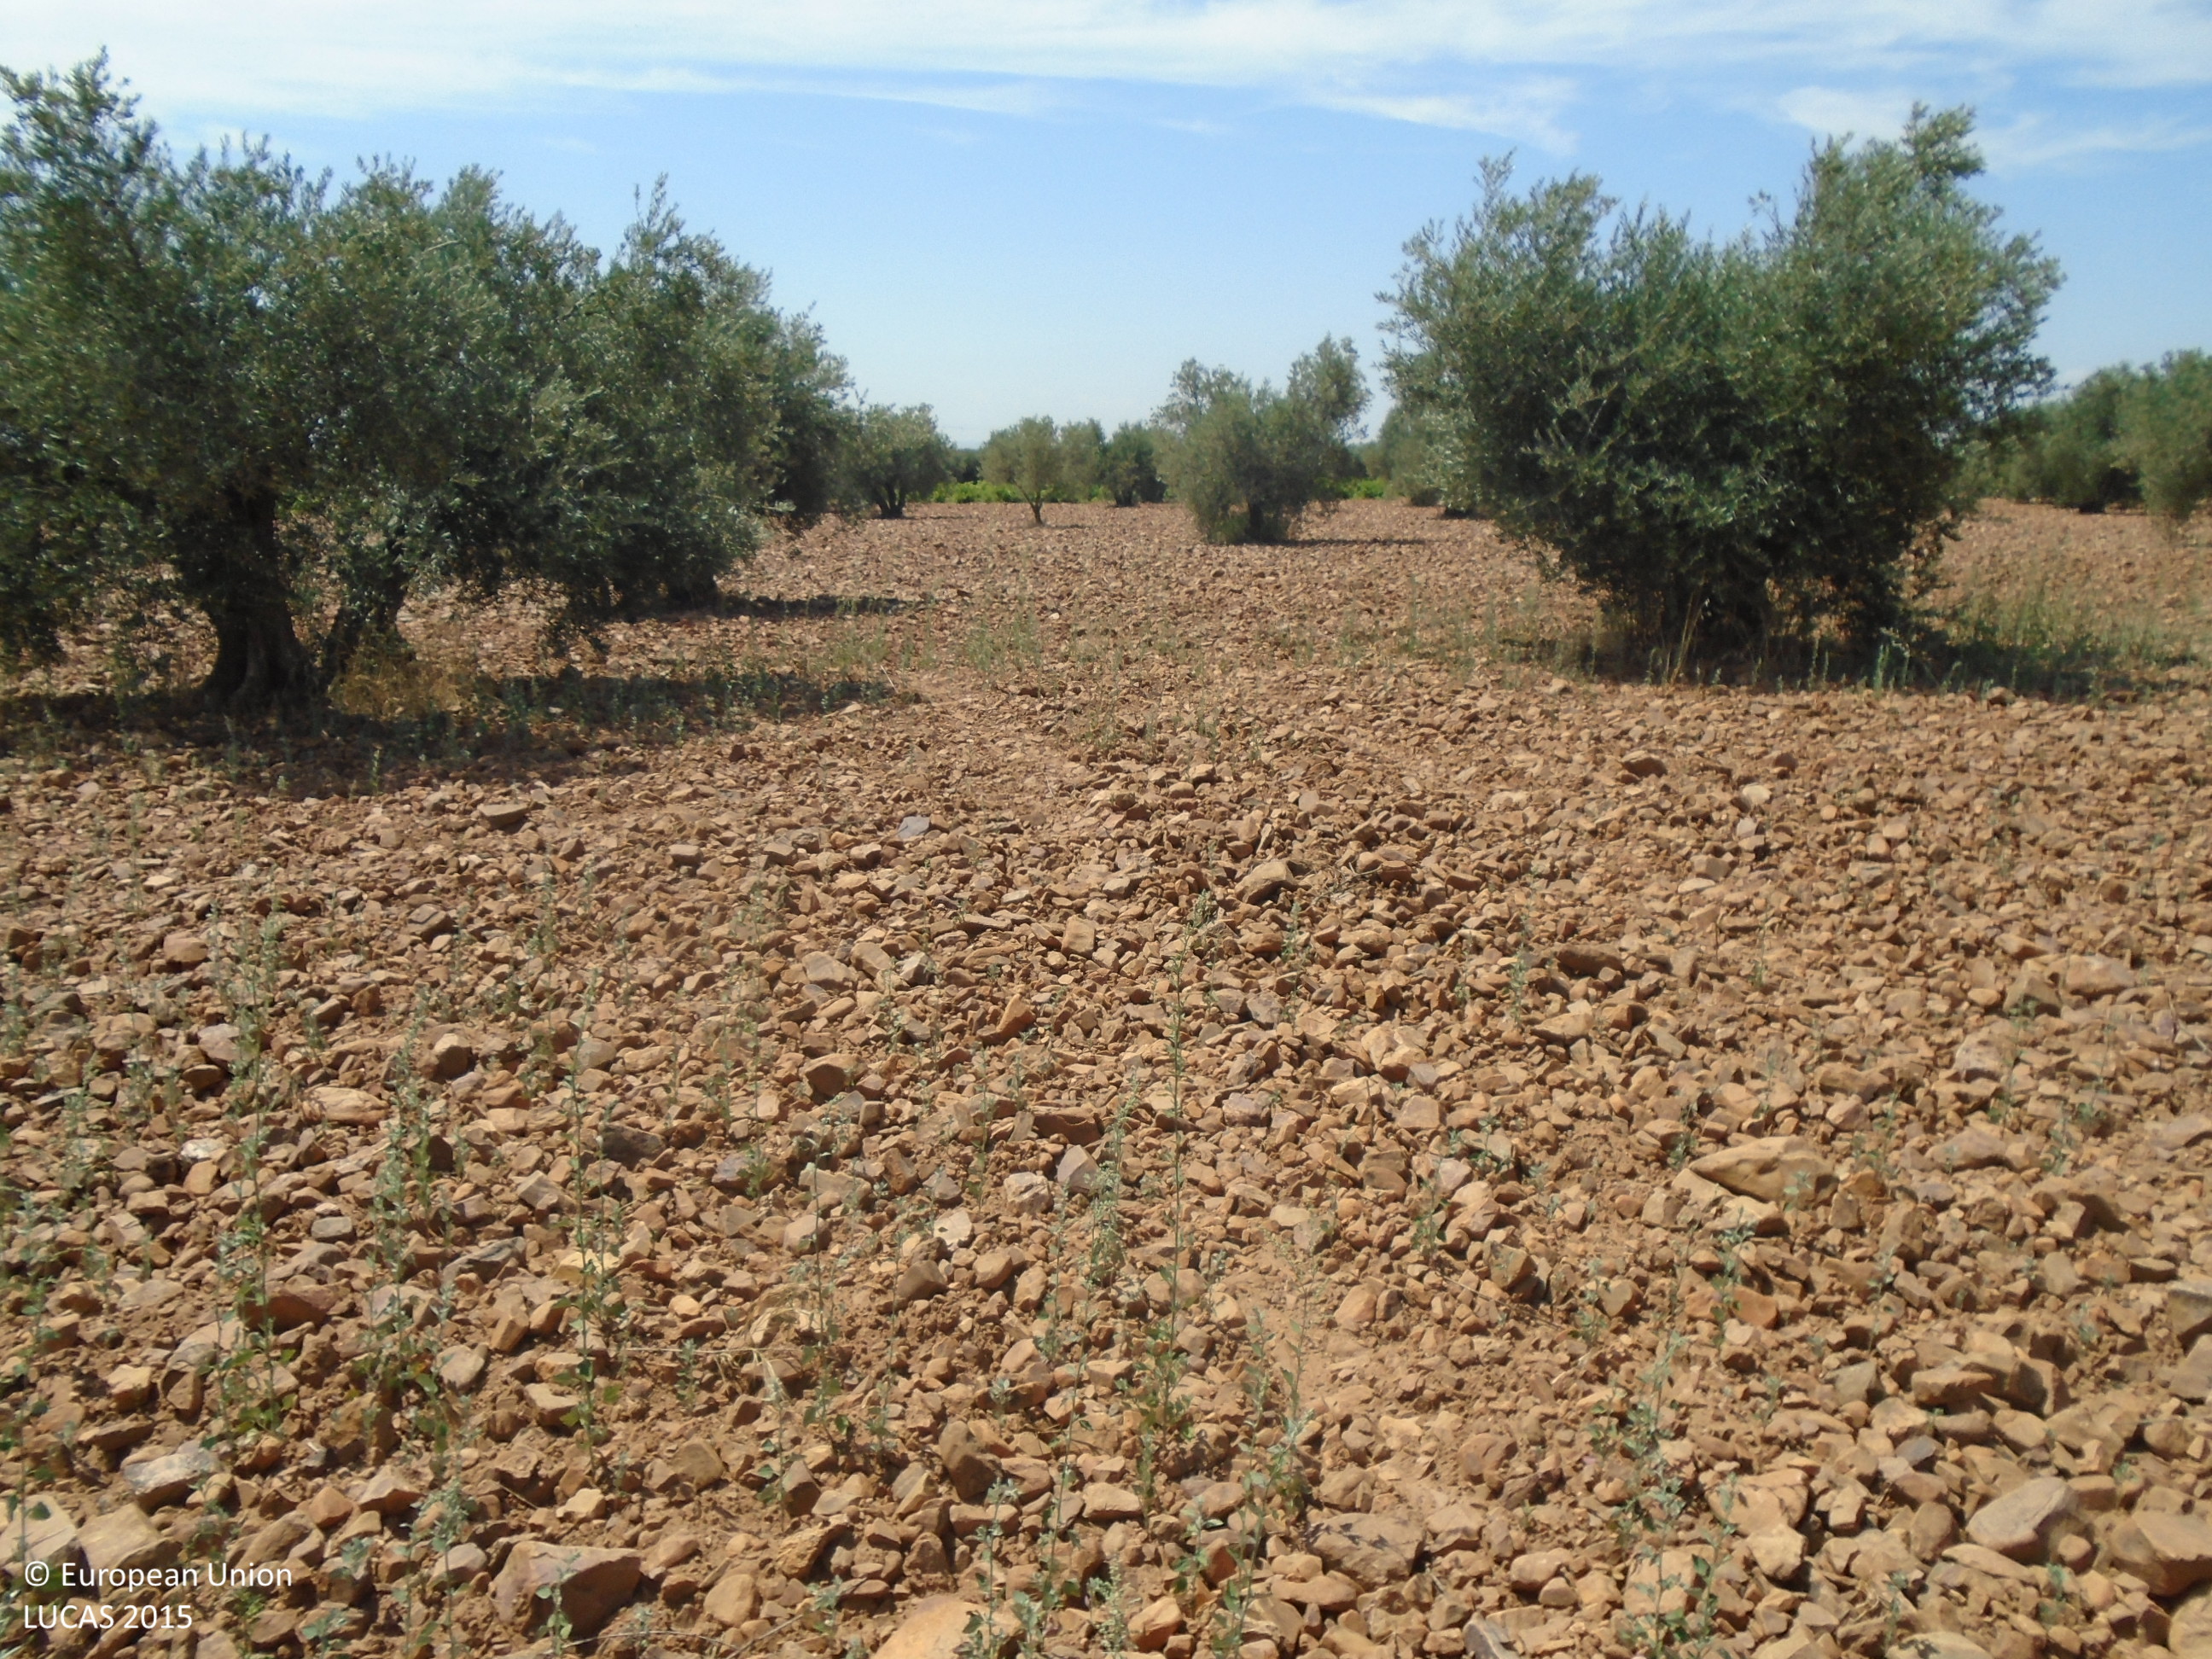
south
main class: Cropland
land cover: Olive groves
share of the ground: 10 - 25 %
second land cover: Other bare soil
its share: > 75 %
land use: Agriculture (excluding fallow land and kitchen gardens)
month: June
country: ES
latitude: 39.2471
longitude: -3.5652
